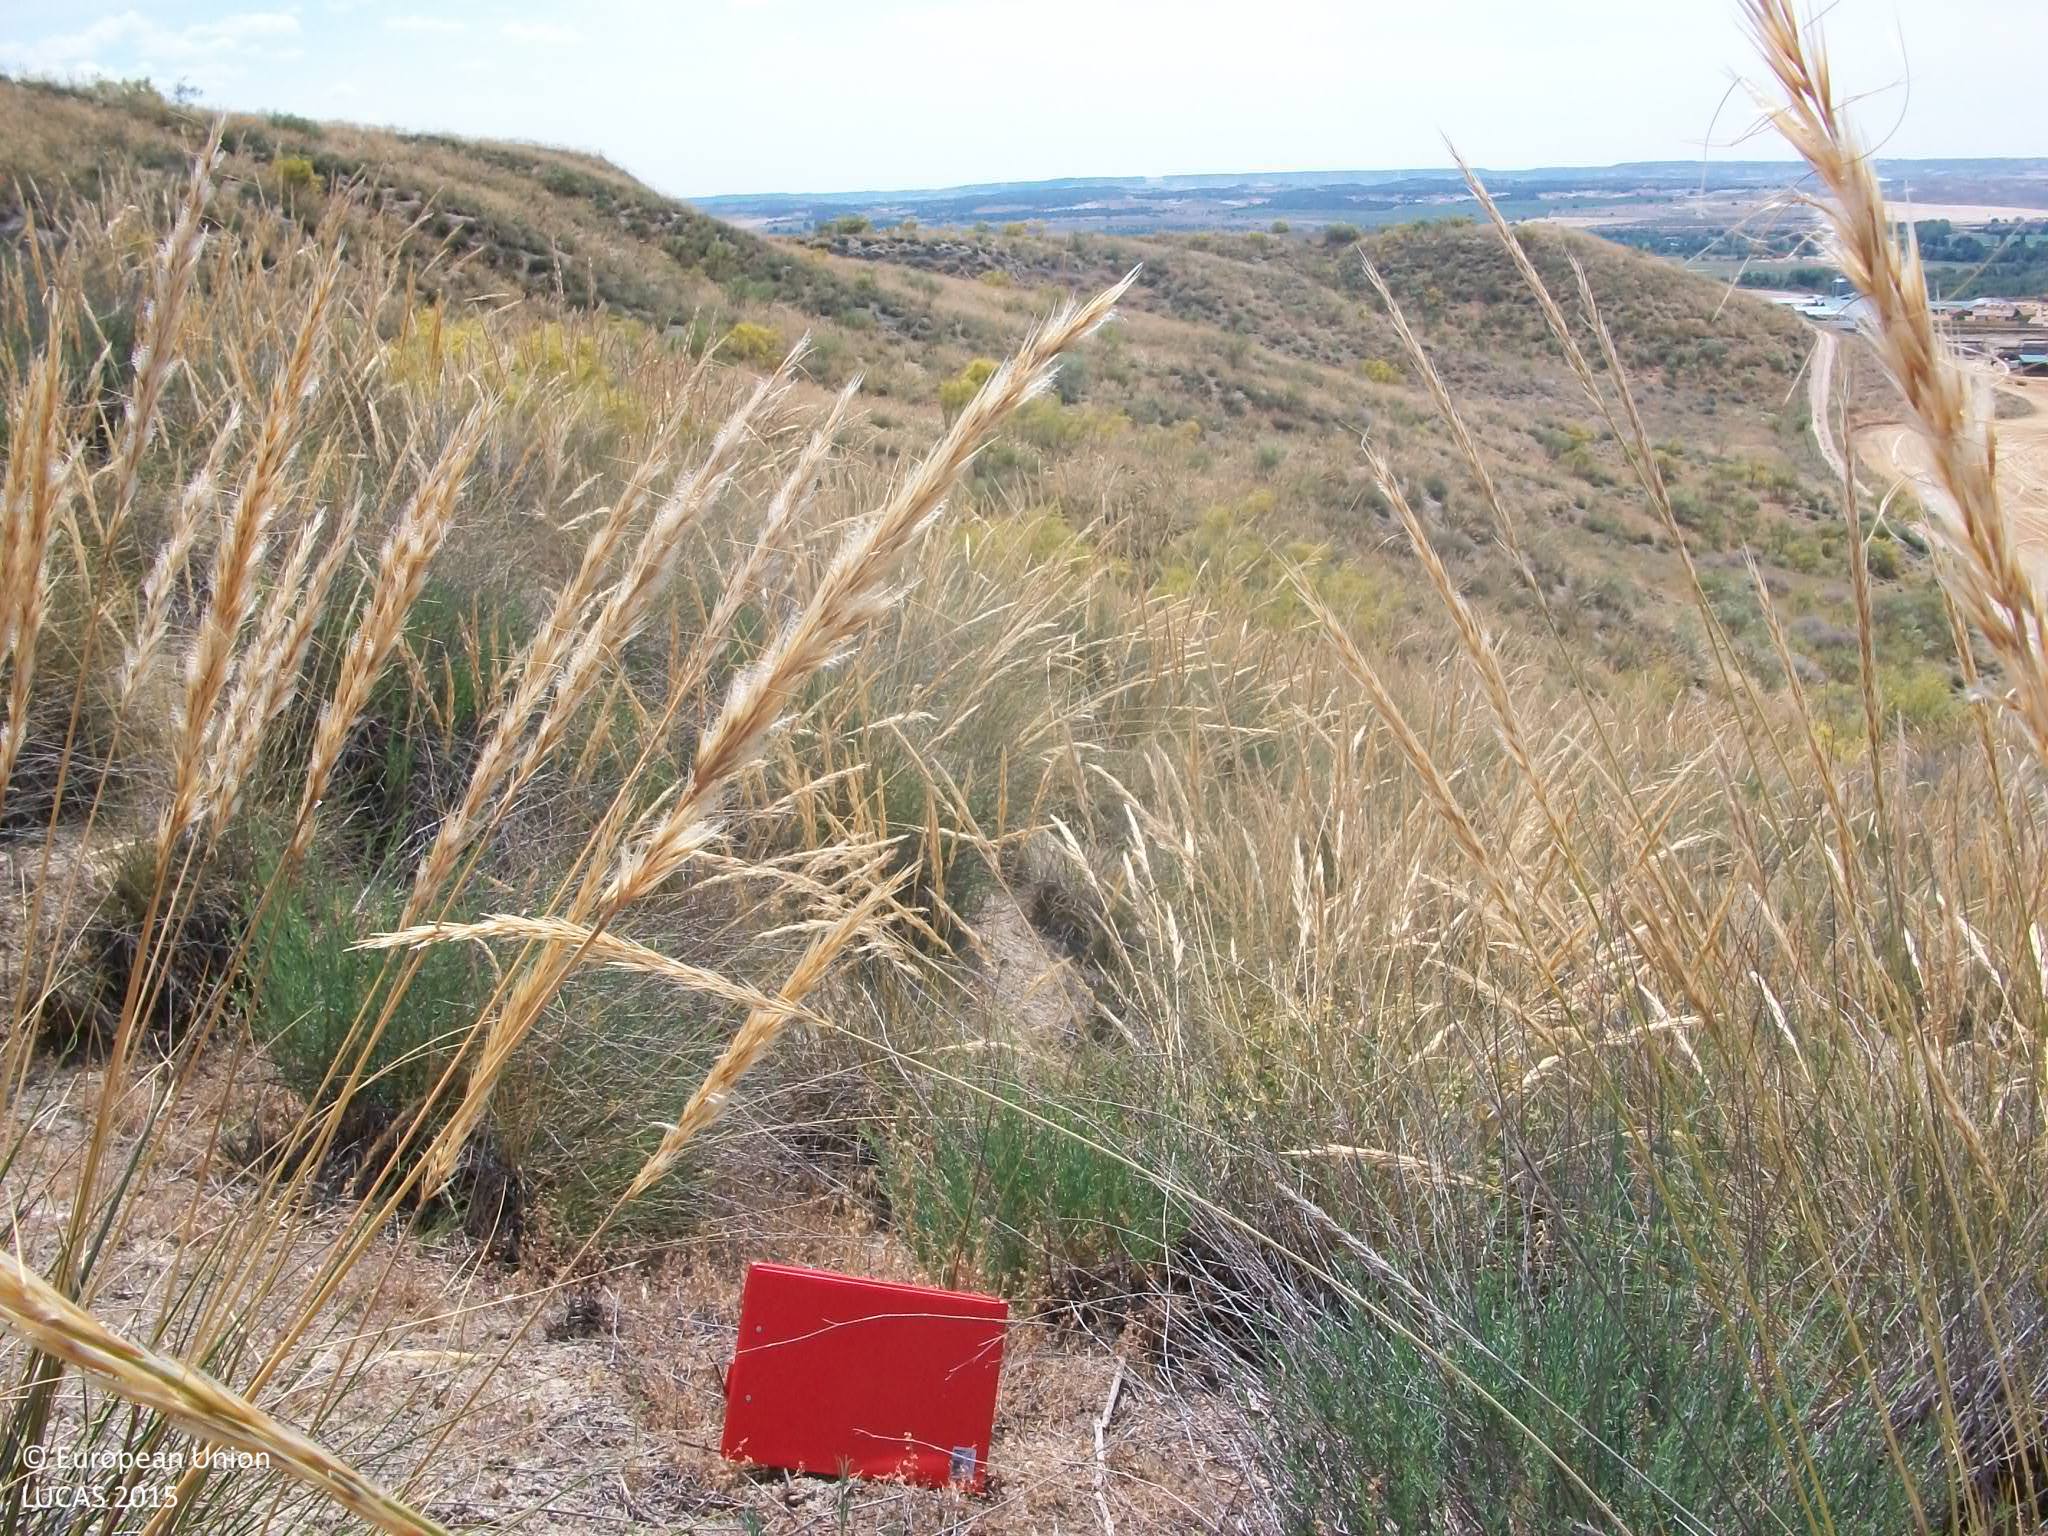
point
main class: Shrubland
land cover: Shrubland without tree cover
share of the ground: > 75 %
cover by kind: shrubs 90 %, consolidated bare surface 10 %
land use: Semi-natural and natural areas not in use
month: May
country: ES
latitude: 40.0329
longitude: -3.7085
